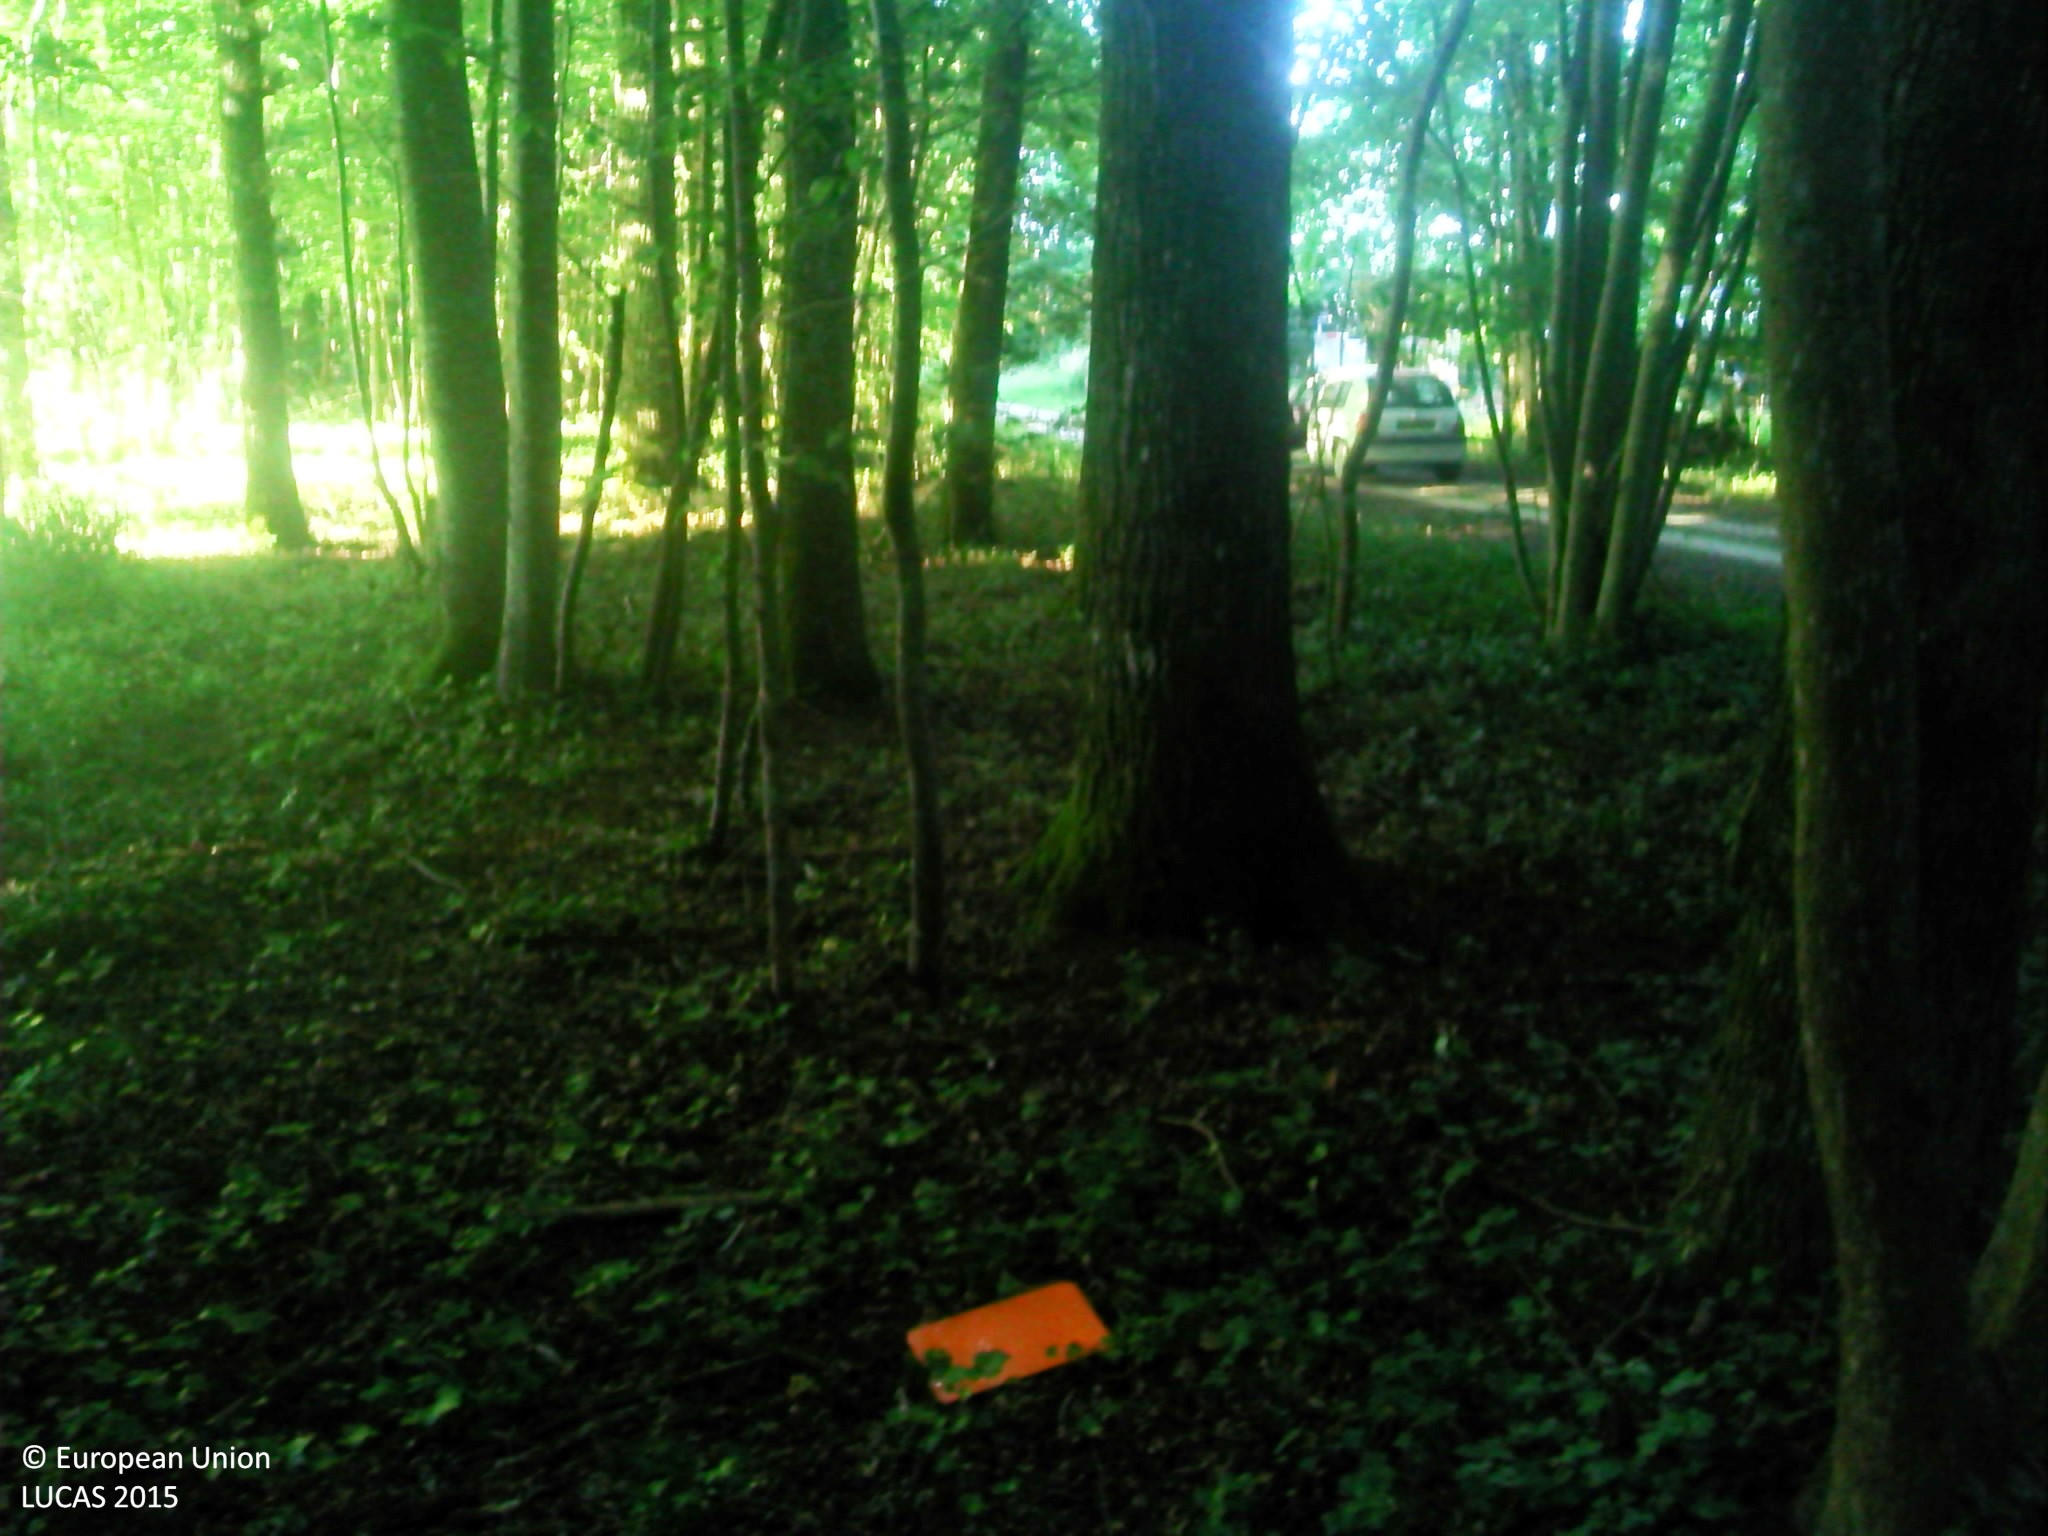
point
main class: Woodland
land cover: Broadleaved woodland
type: mesophytic deciduous forest
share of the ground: > 75 %
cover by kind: unconsolidated bare surface 60 %, broadleaved forest trees 20 %, herbaceous plants 20 %
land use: Forestry
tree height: > 5 m
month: June
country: FR
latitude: 47.2345
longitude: 1.3873
